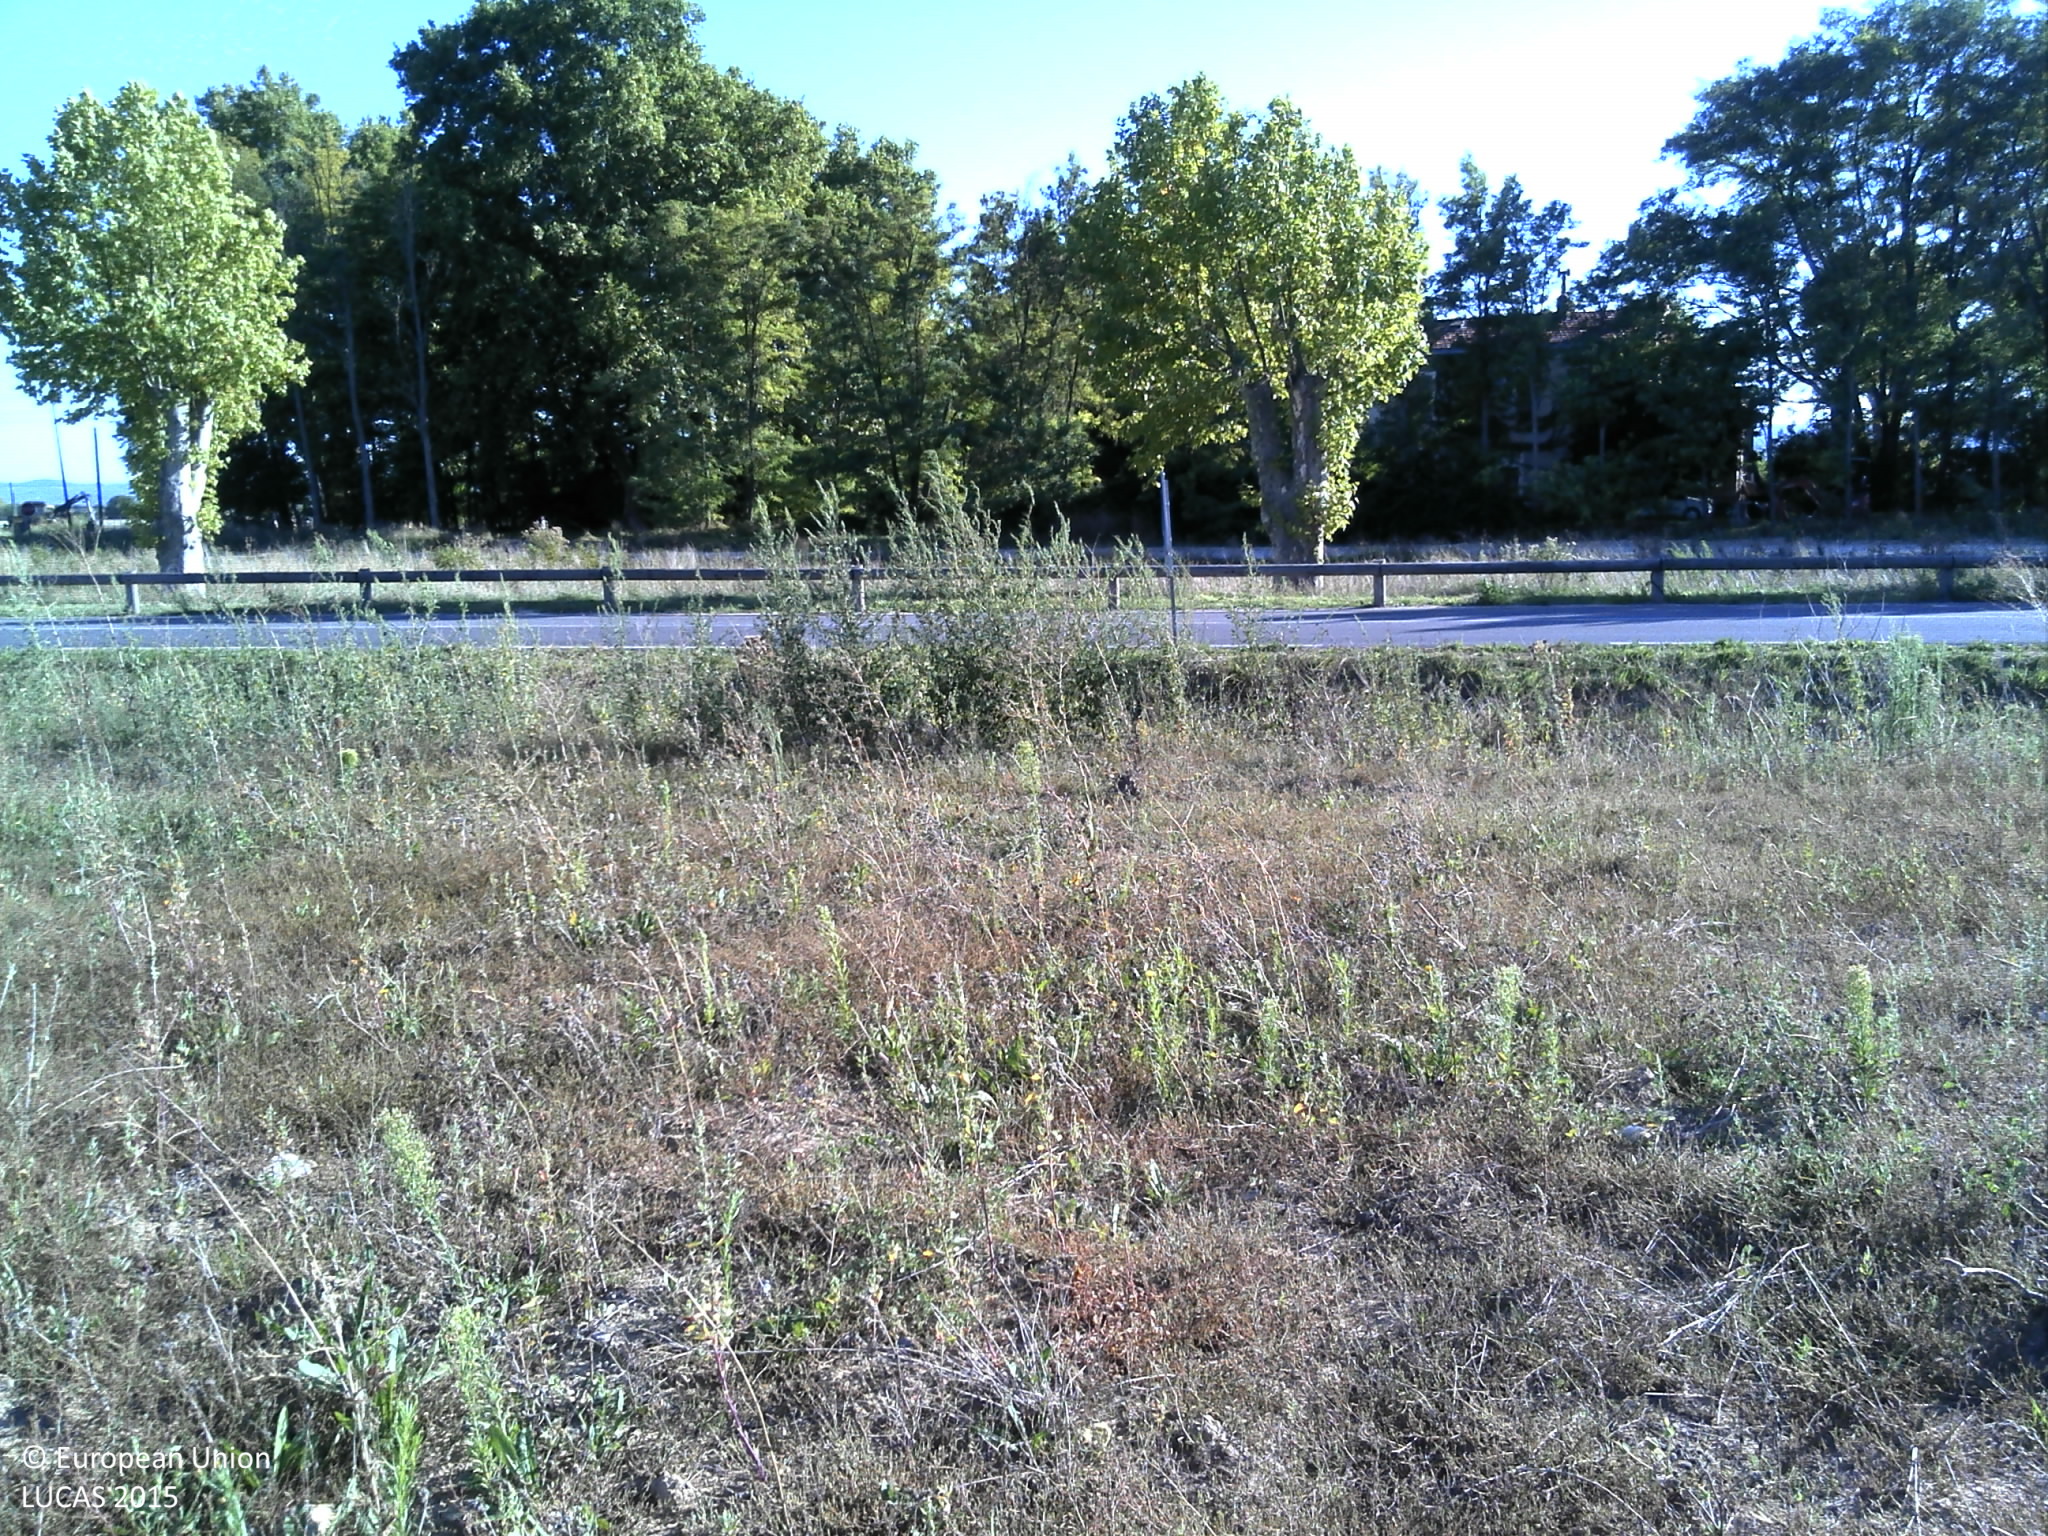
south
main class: Grassland
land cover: Spontaneously vegetated surfaces
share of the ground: > 75 %
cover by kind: herbaceous plants 70 %, unconsolidated bare surface 15 %, consolidated bare surface 10 %, shrubs 5 %
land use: Abandoned areas
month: September
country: FR
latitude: 43.7079
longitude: 5.4298
